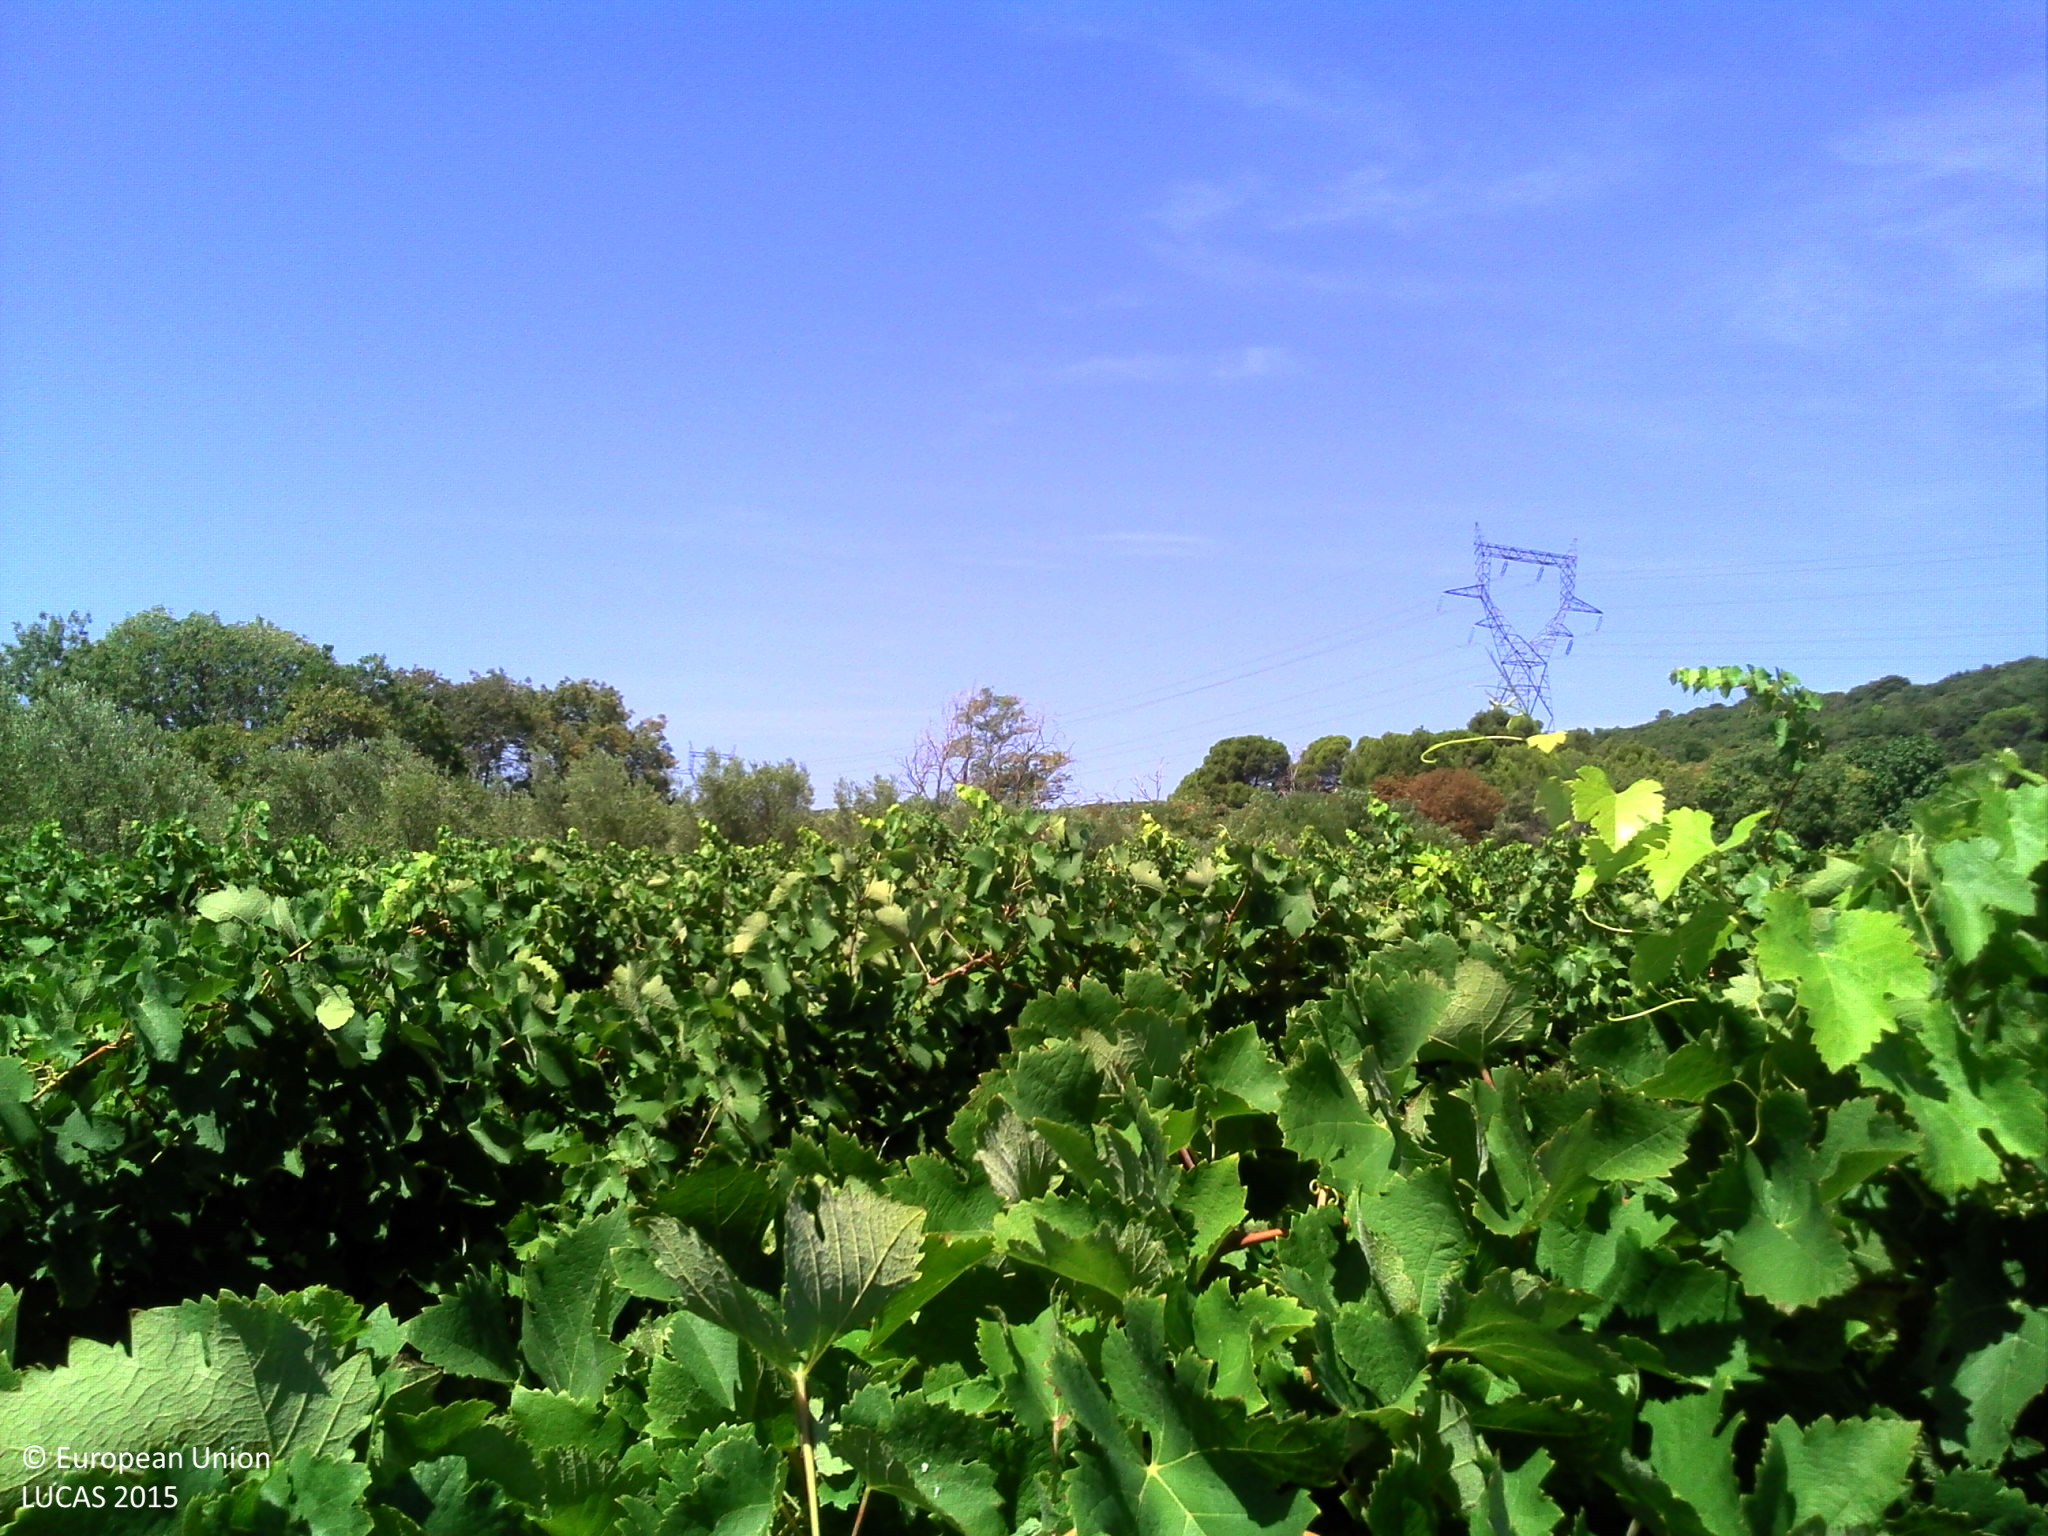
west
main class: Cropland
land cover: Vineyards
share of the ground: 10 - 25 %
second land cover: Other bare soil
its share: > 75 %
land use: Agriculture (excluding fallow land and kitchen gardens)
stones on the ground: 25 - 50 %
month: August
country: FR
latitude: 43.5392
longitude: 3.3384
